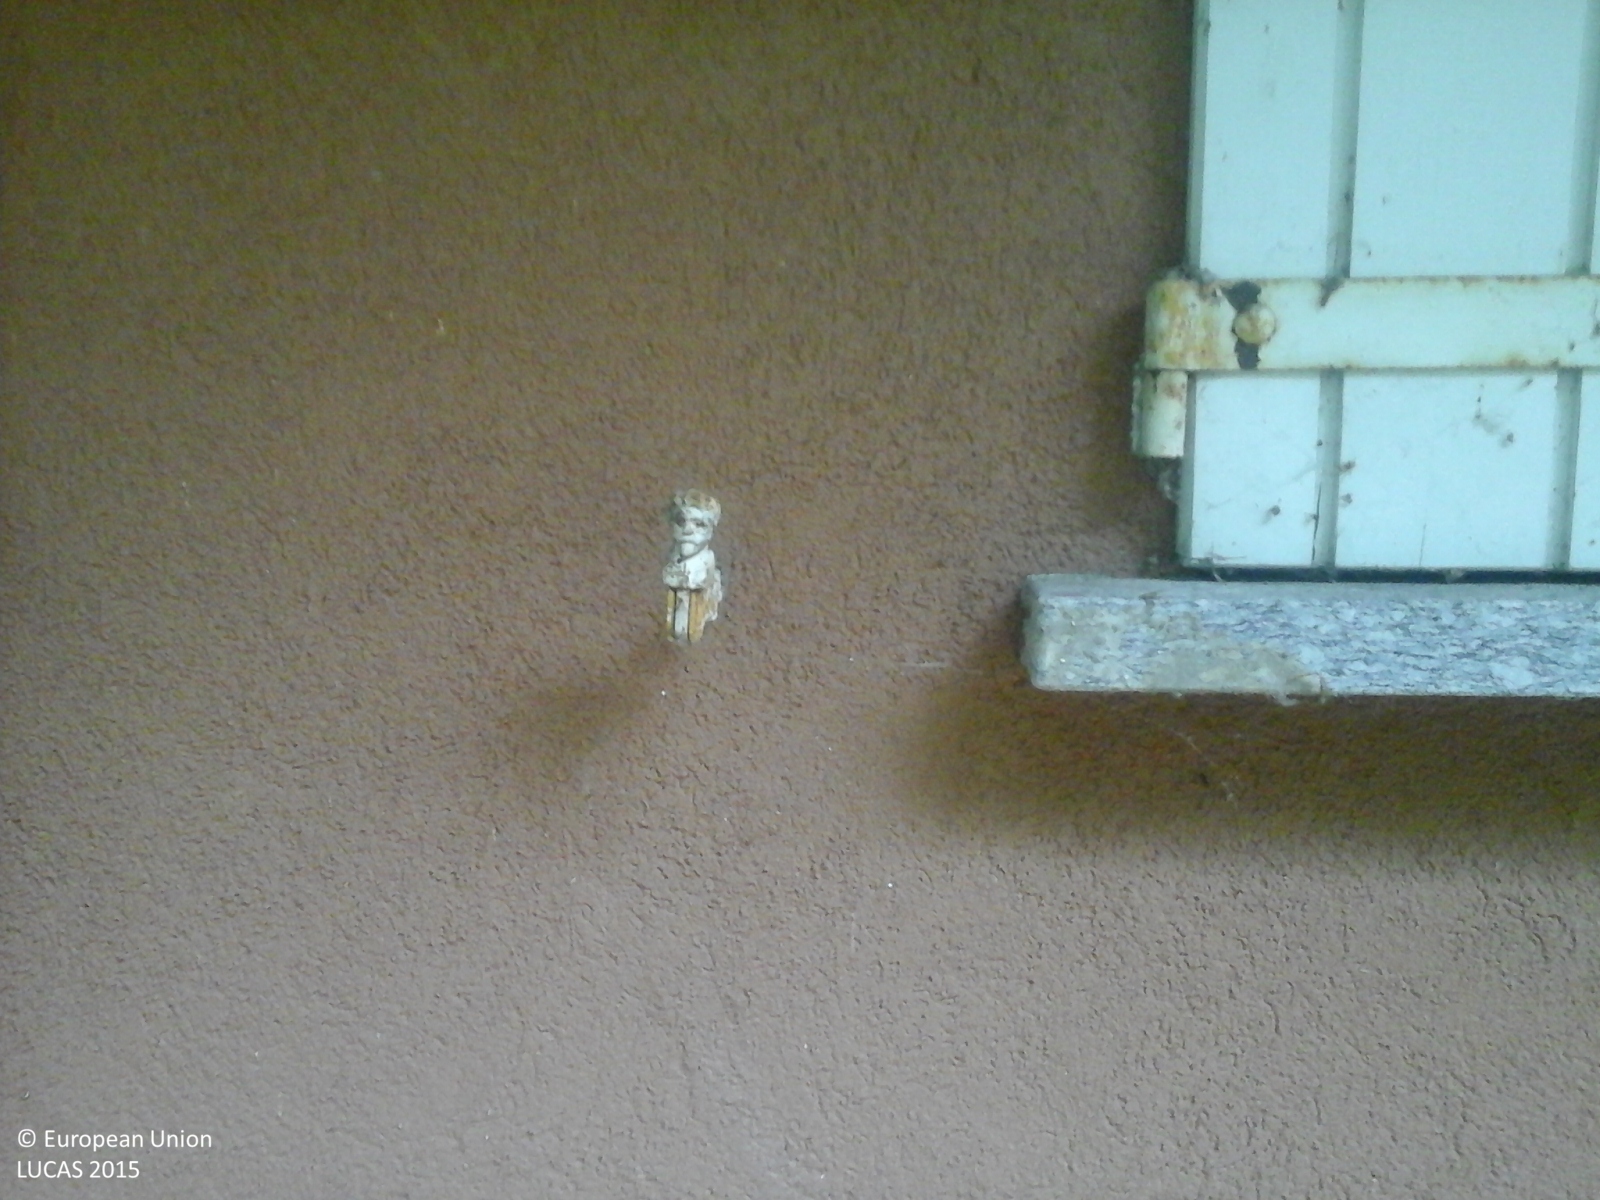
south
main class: Woodland
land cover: Broadleaved woodland
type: thermophilous deciduous forest
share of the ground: > 75 %
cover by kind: broadleaved forest trees 100 %
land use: Forestry
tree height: > 5 m
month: July
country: IT
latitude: 45.9342
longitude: 9.2402
